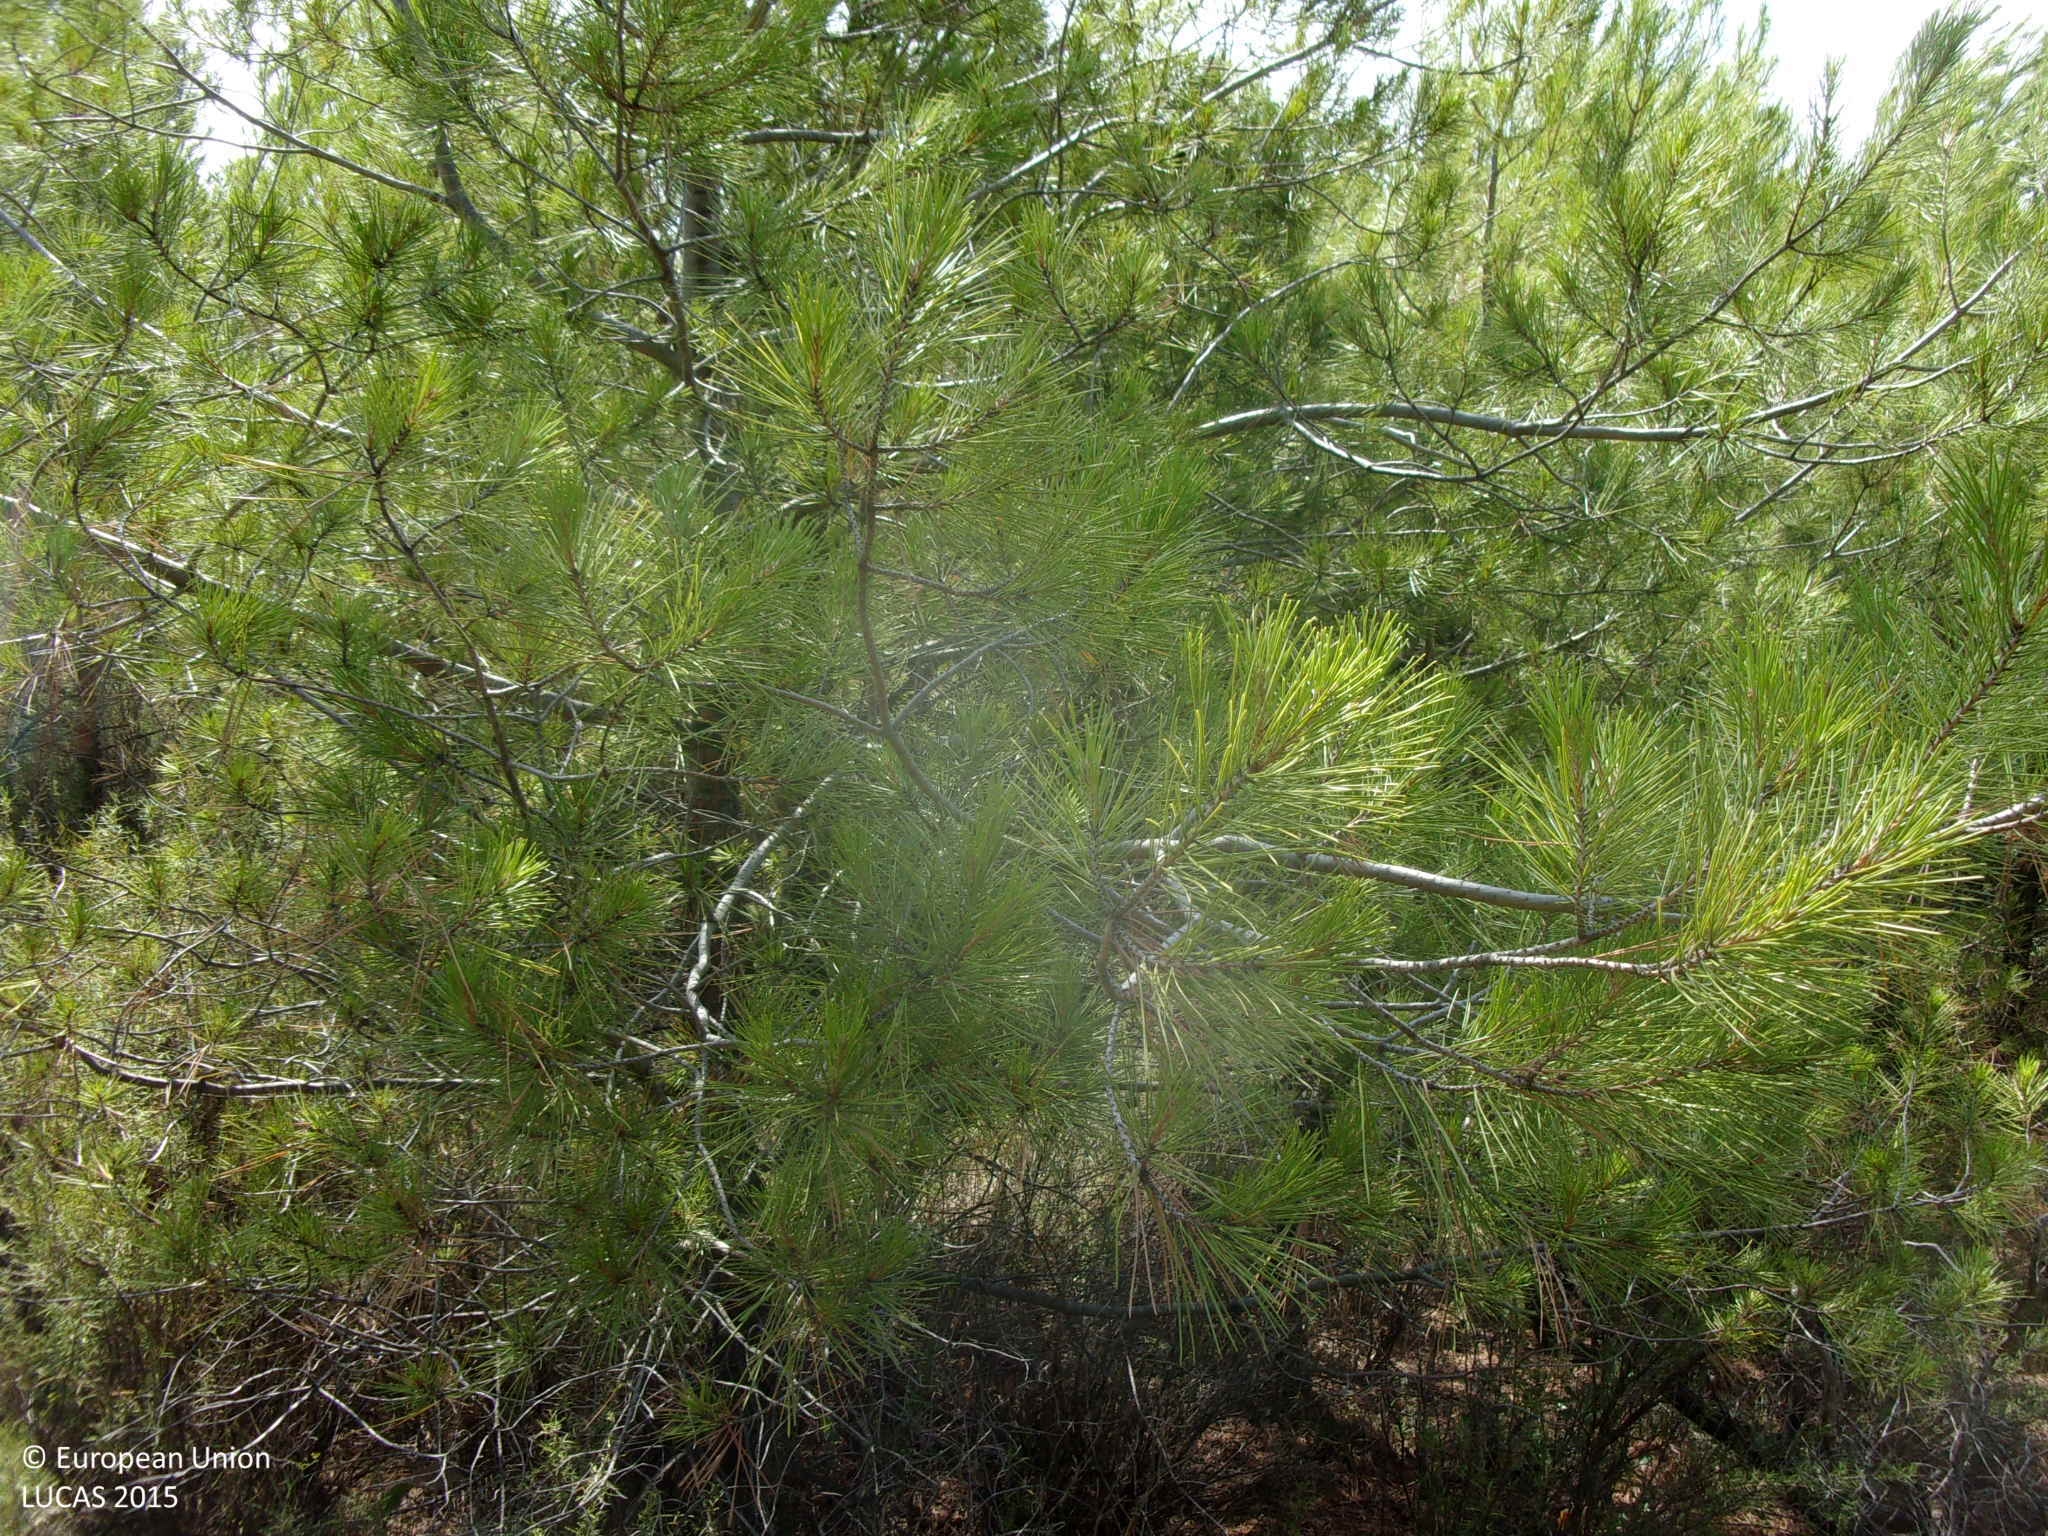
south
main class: Woodland
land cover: Pine dominated mixed woodland
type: coniferous forest of the mediterranean region
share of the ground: > 75 %
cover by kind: coniferous forest trees 60 %, broadleaved forest trees 30 %, shrubs 10 %
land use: Forestry
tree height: < 5 m
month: August
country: ES
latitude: 42.4810
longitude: -1.4079
